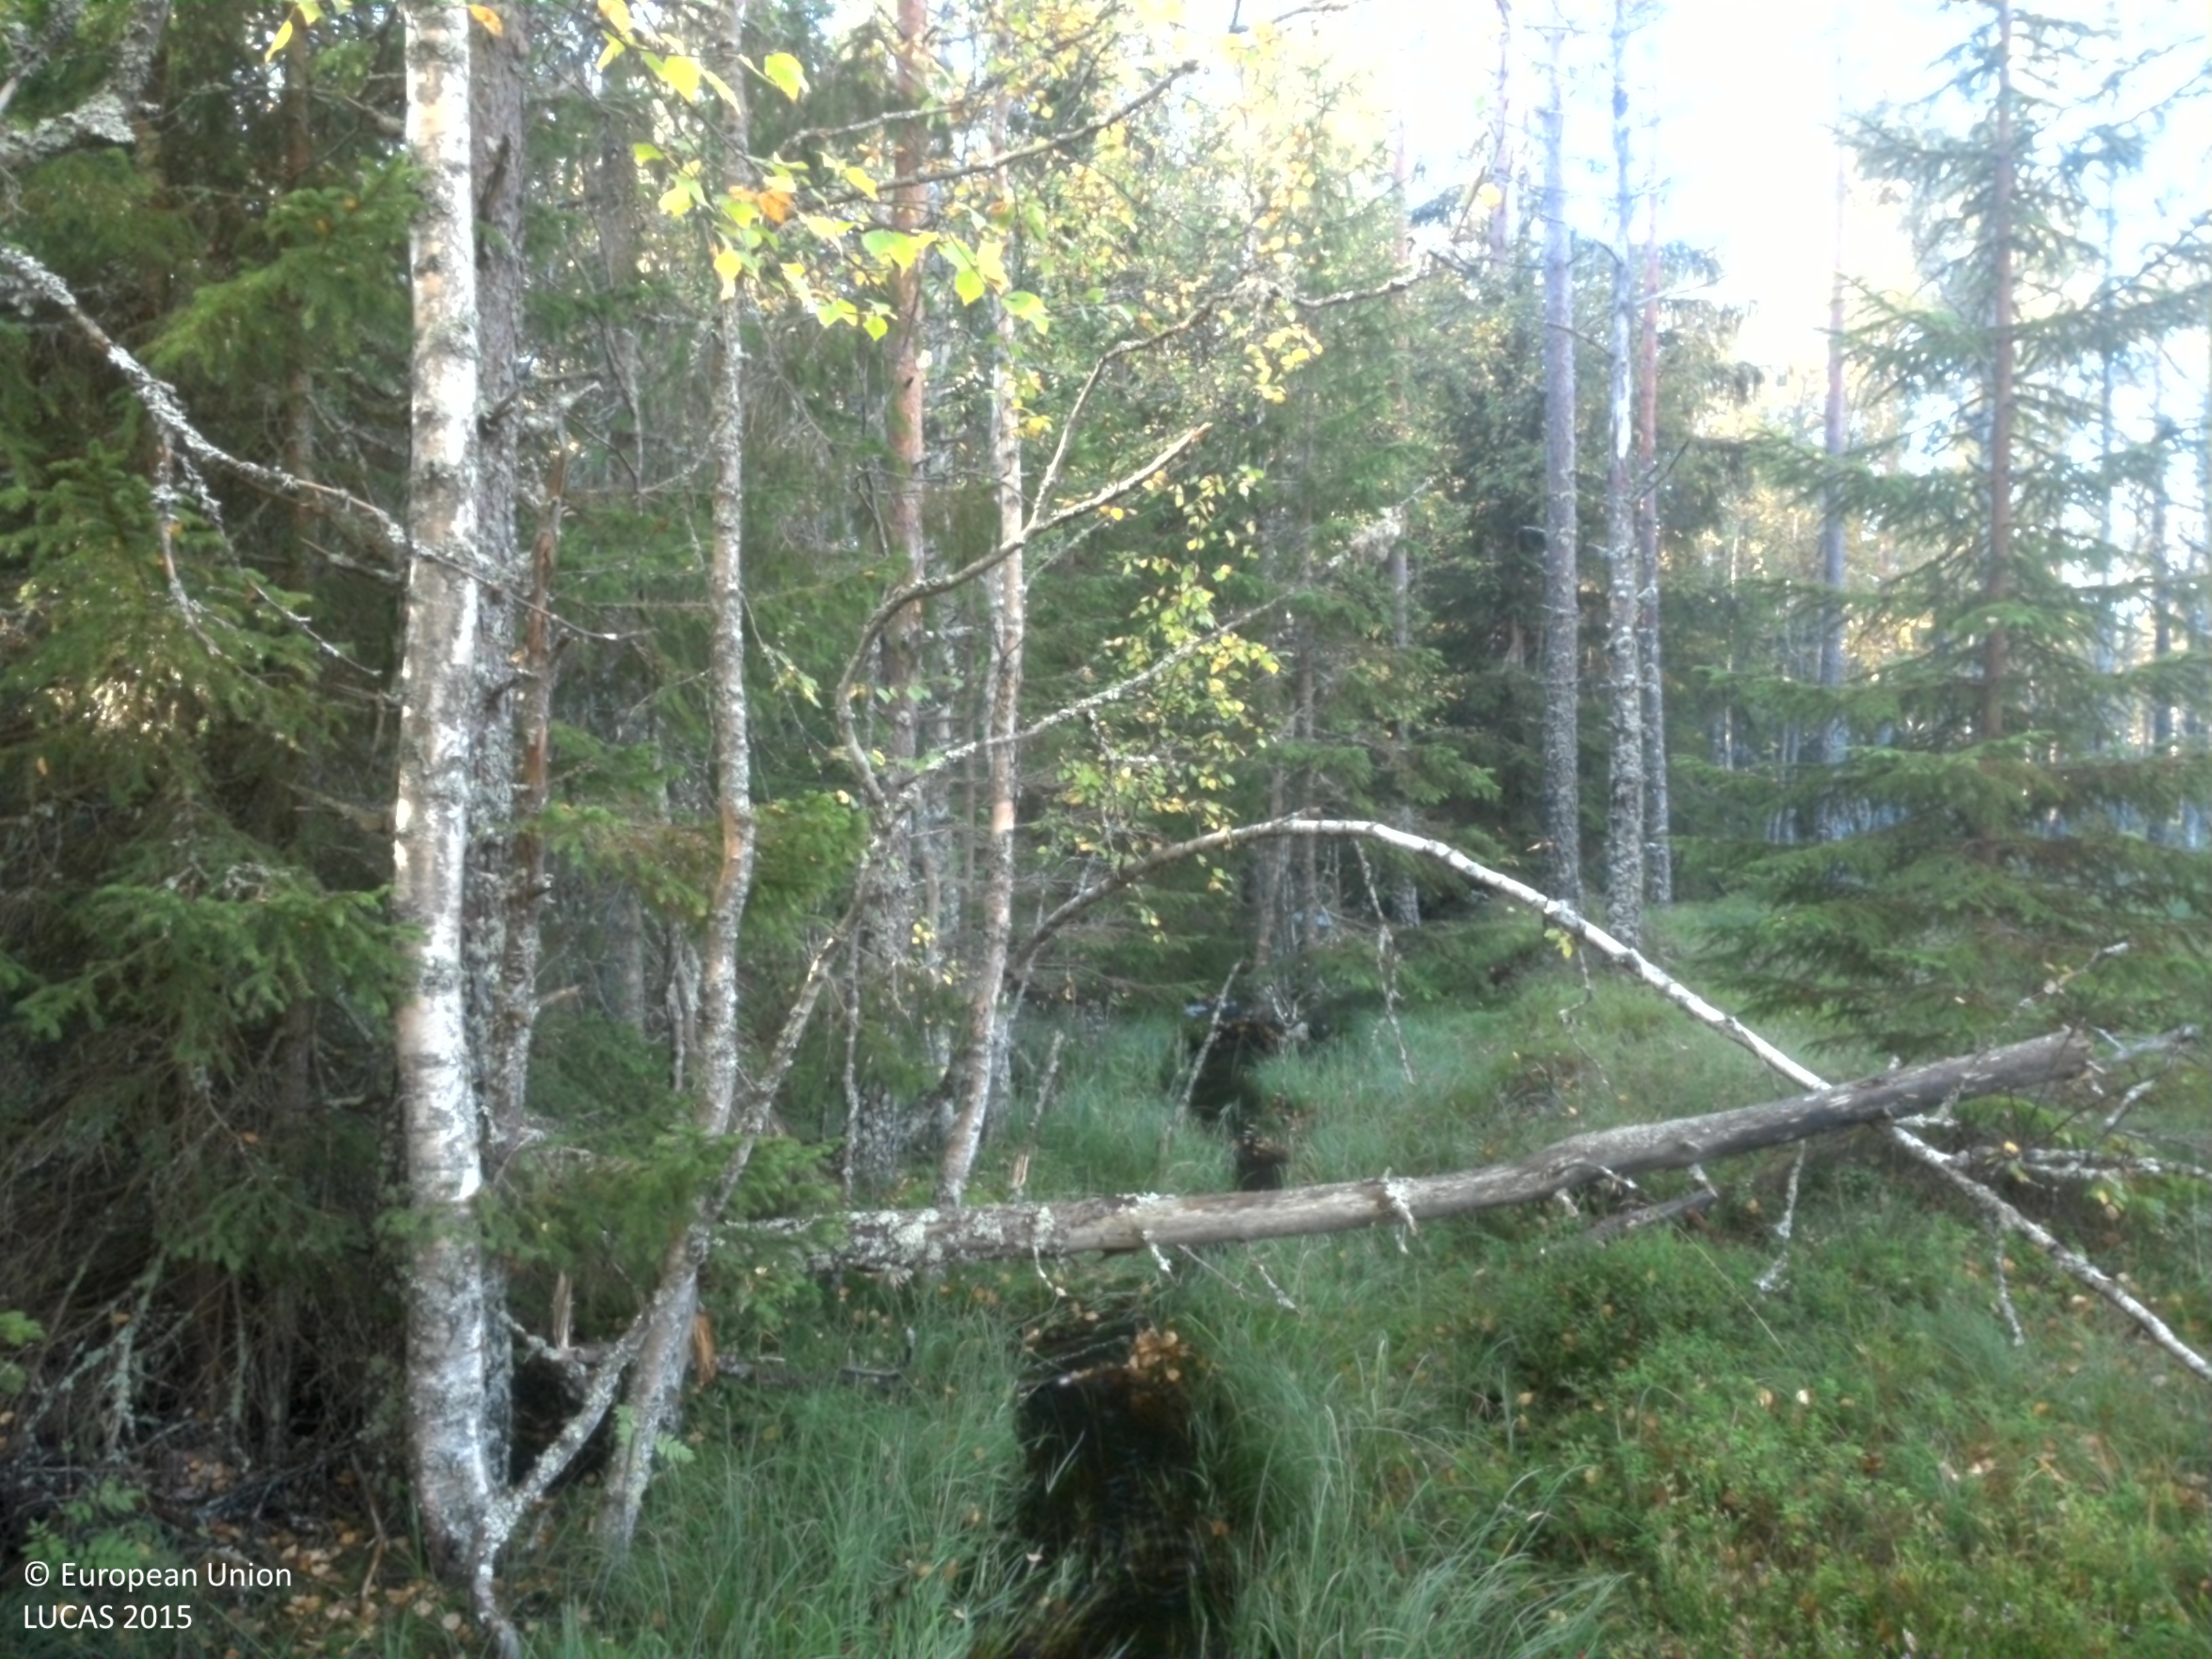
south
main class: Woodland
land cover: Pine dominated mixed woodland
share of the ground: 25 - 50 %
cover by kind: herbaceous plants 50 %, coniferous forest trees 15 %, broadleaved forest trees 15 %, shrubs 10 %, lichens and mosses 10 %
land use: Forestry
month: September
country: SE
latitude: 59.9213
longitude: 15.2307
